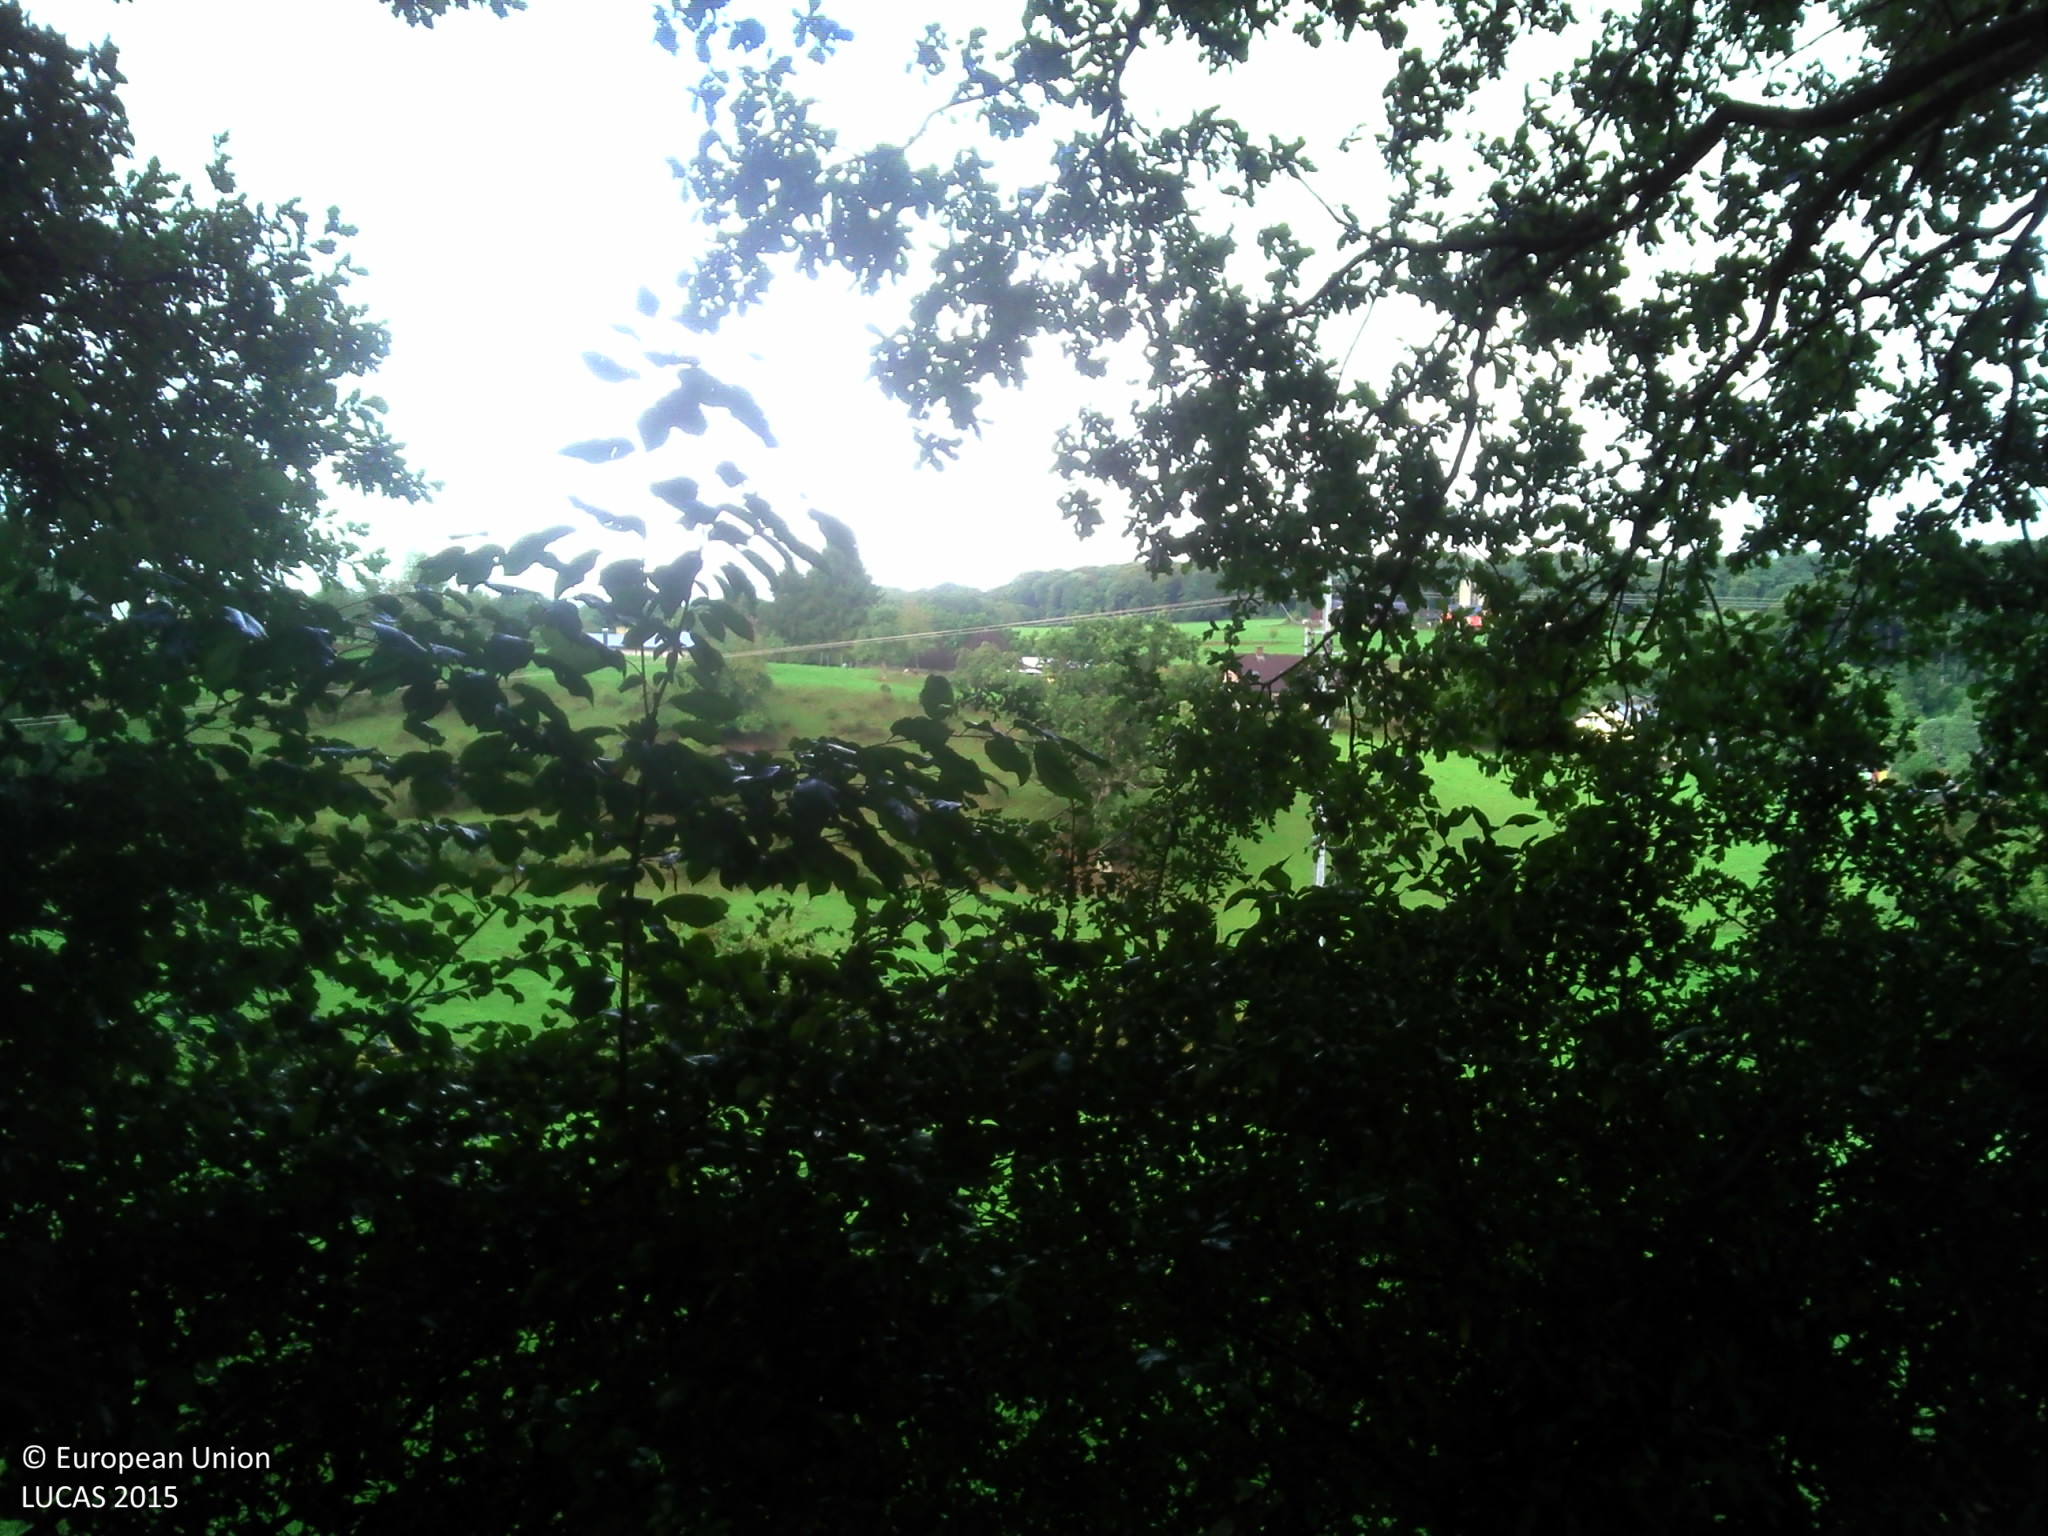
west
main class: Woodland
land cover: Broadleaved woodland
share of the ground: > 75 %
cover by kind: broadleaved forest trees 70 %, herbaceous plants 20 %, unconsolidated bare surface 10 %
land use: Residential
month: September
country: LU
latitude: 49.7725
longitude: 6.0141
